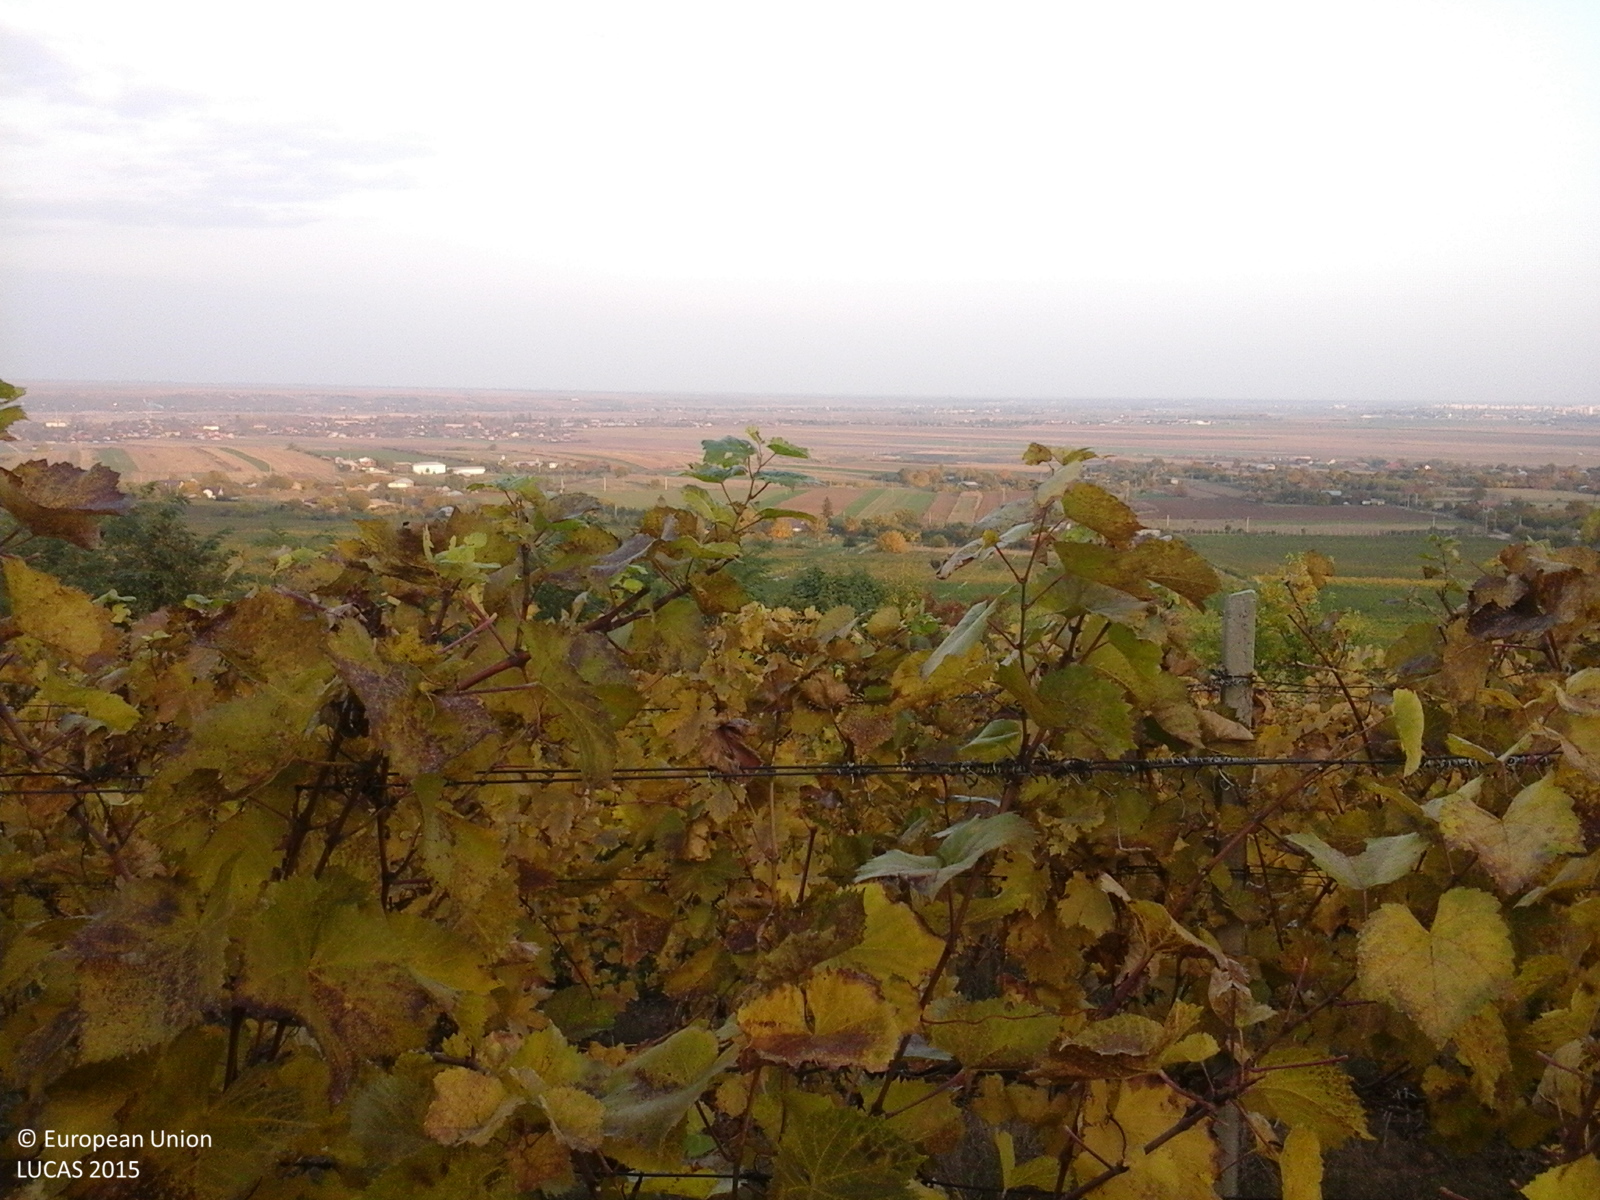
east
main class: Cropland
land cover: Vineyards
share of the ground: > 75 %
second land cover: Grassland without tree/shrub cover
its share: > 75 %
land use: Agriculture (excluding fallow land and kitchen gardens)
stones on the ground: < 10 %
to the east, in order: Vineyards; Grassland without tree/shrub cover; Abandoned hedges; Vineyards; Abandoned hedges; Grass margins; Tracks; Grass margins; Vineyards
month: October
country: RO
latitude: 45.1938
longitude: 26.6878
